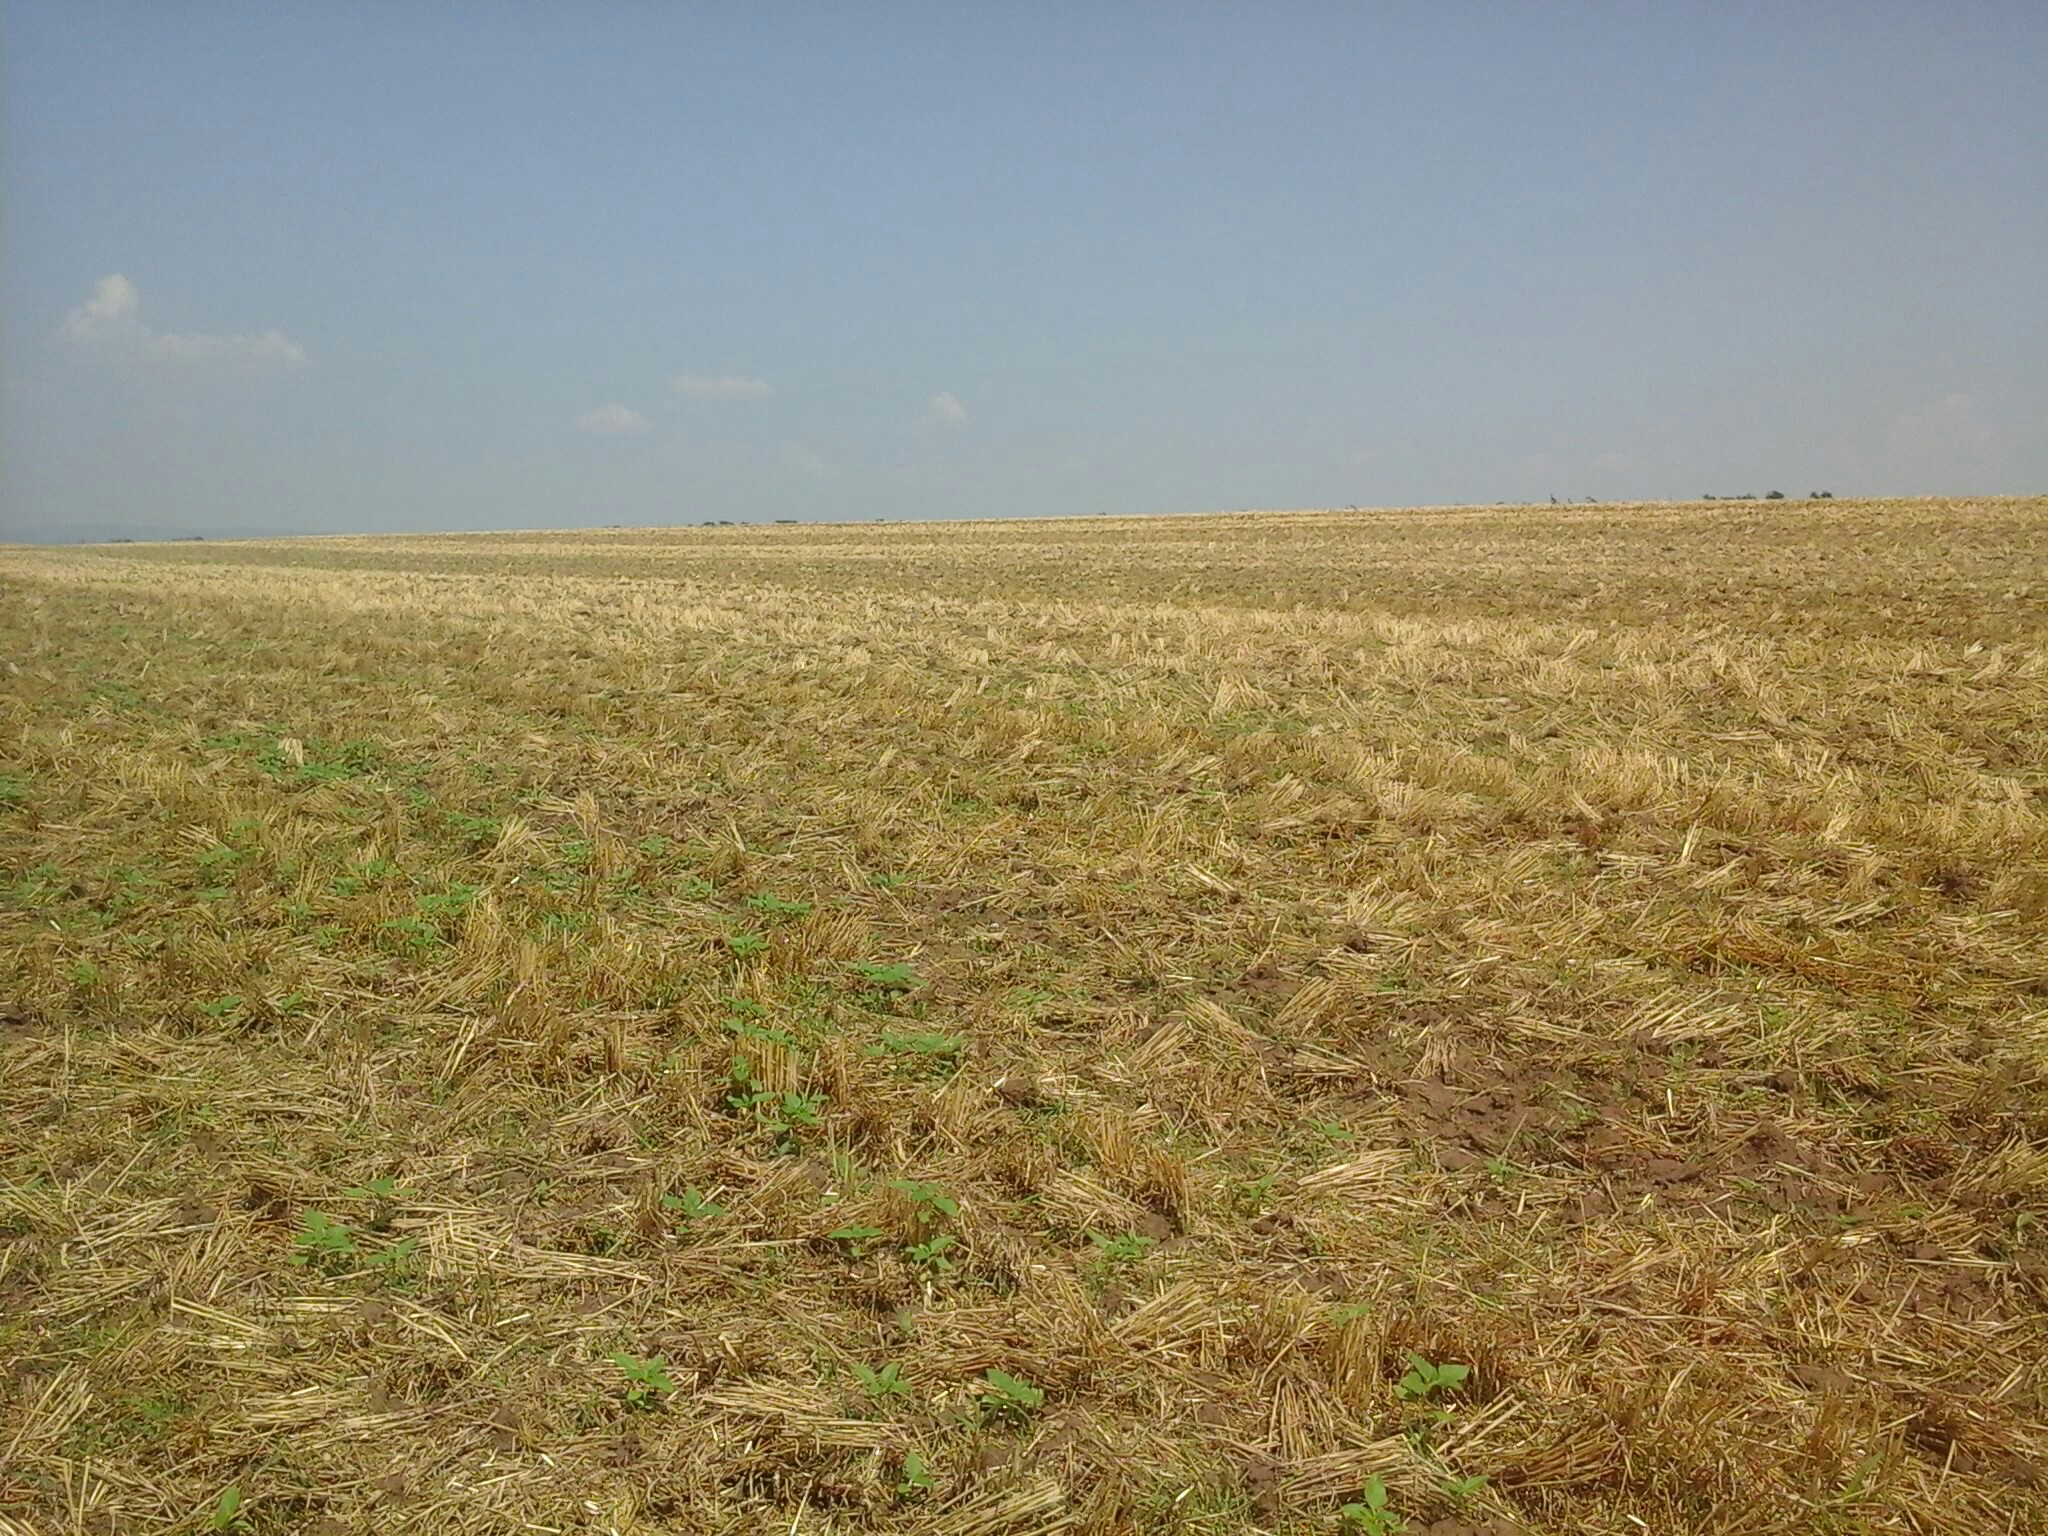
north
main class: Cropland
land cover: Common wheat
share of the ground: < 10 %
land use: Agriculture (excluding fallow land and kitchen gardens)
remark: Harvested field
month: August
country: HU
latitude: 47.3479
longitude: 18.5516
